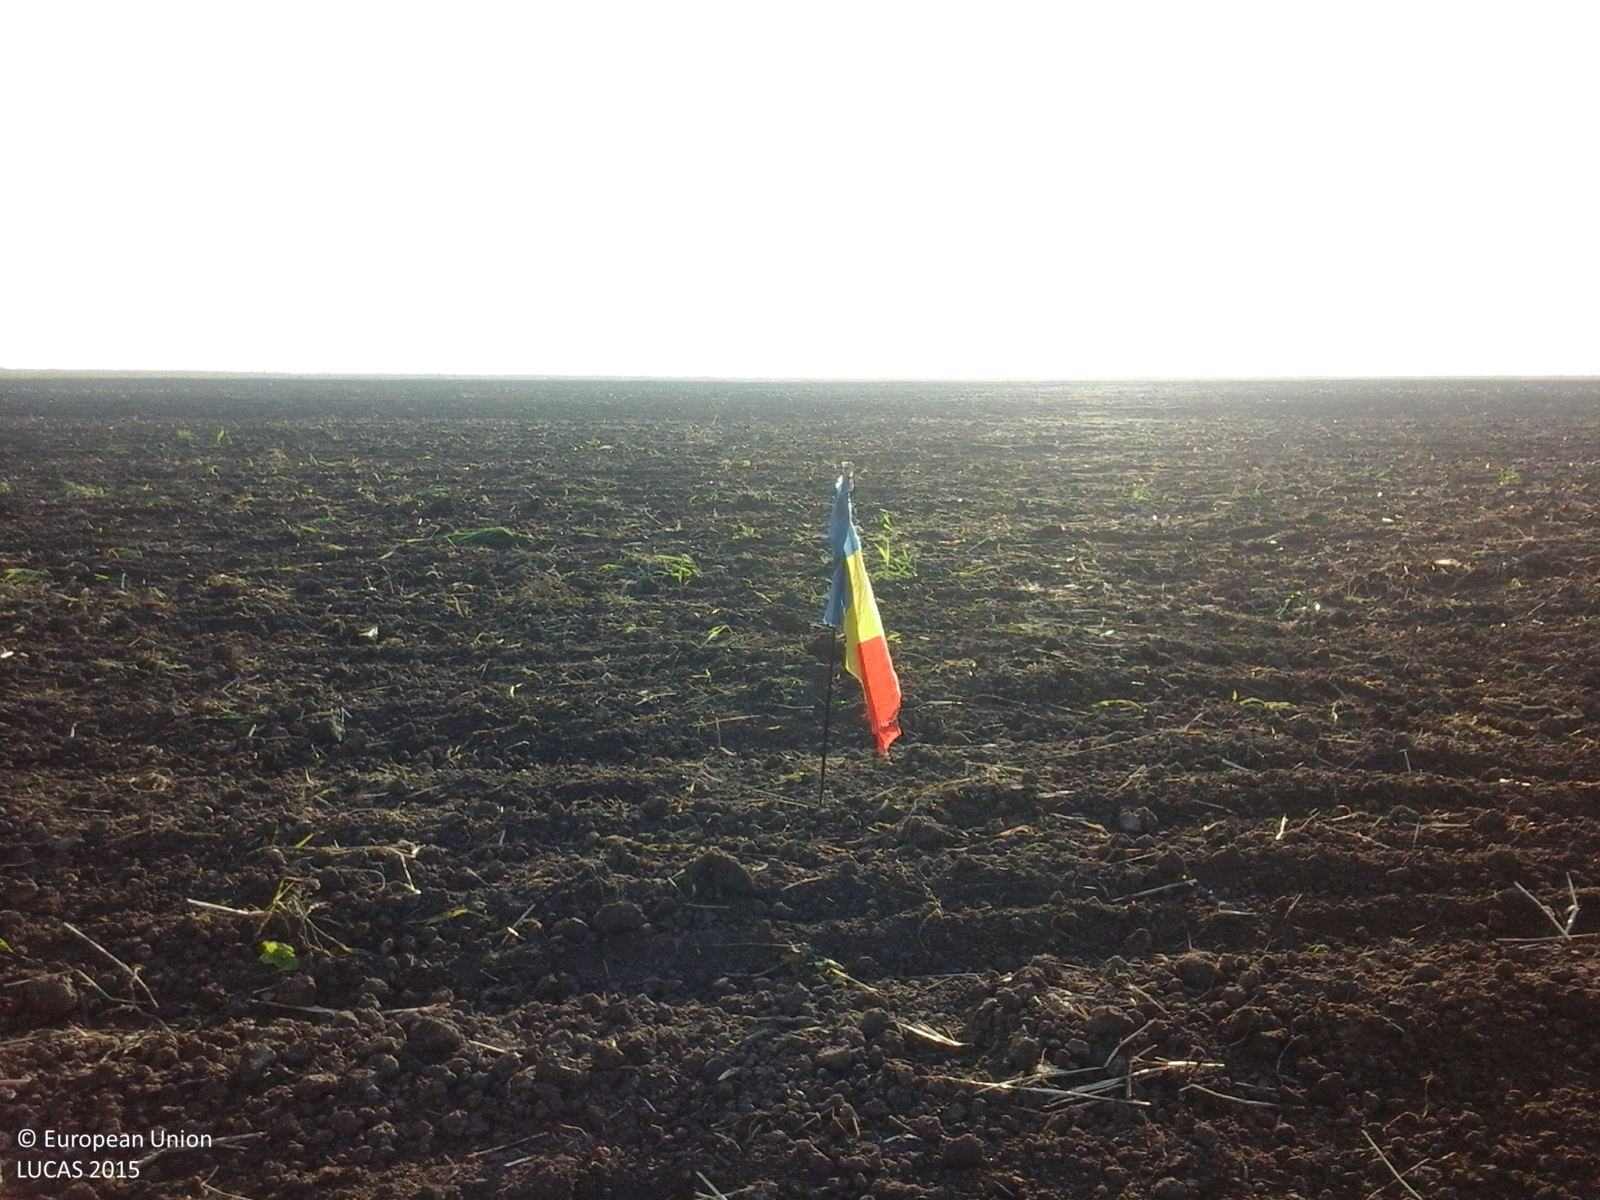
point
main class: Cropland
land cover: Common wheat
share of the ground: < 10 %
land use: Agriculture (excluding fallow land and kitchen gardens)
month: October
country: RO
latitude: 45.1709
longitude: 26.9423
